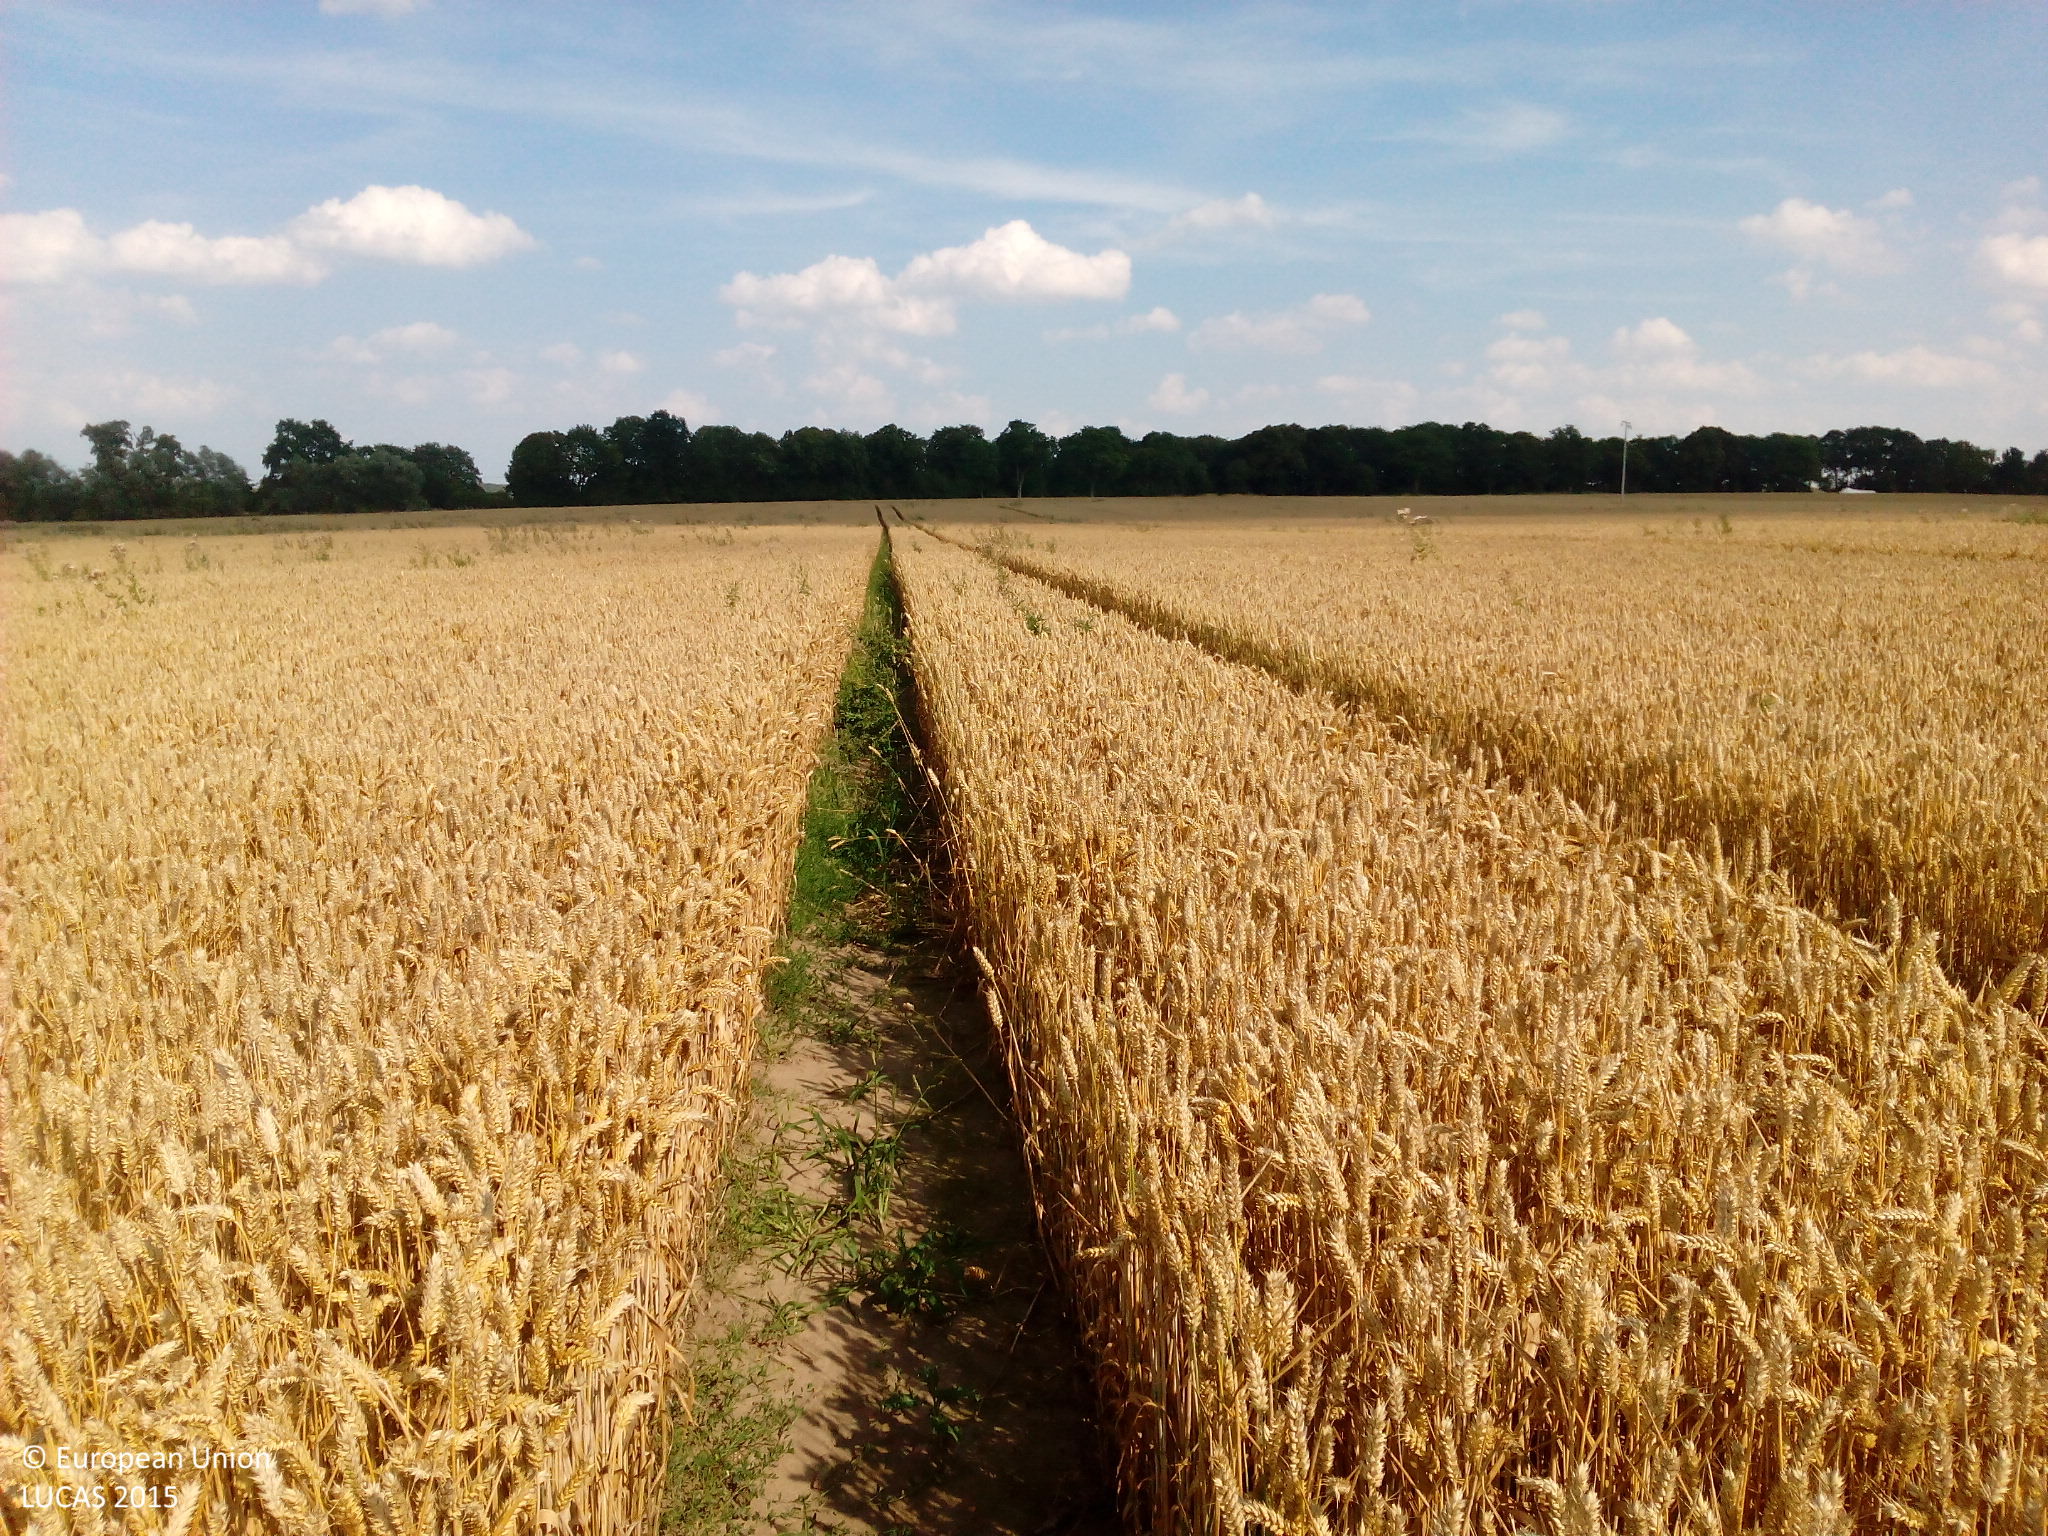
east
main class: Cropland
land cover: Common wheat
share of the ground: > 75 %
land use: Agriculture (excluding fallow land and kitchen gardens)
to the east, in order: Common wheat
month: August
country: DE
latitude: 53.5821
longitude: 13.6099
